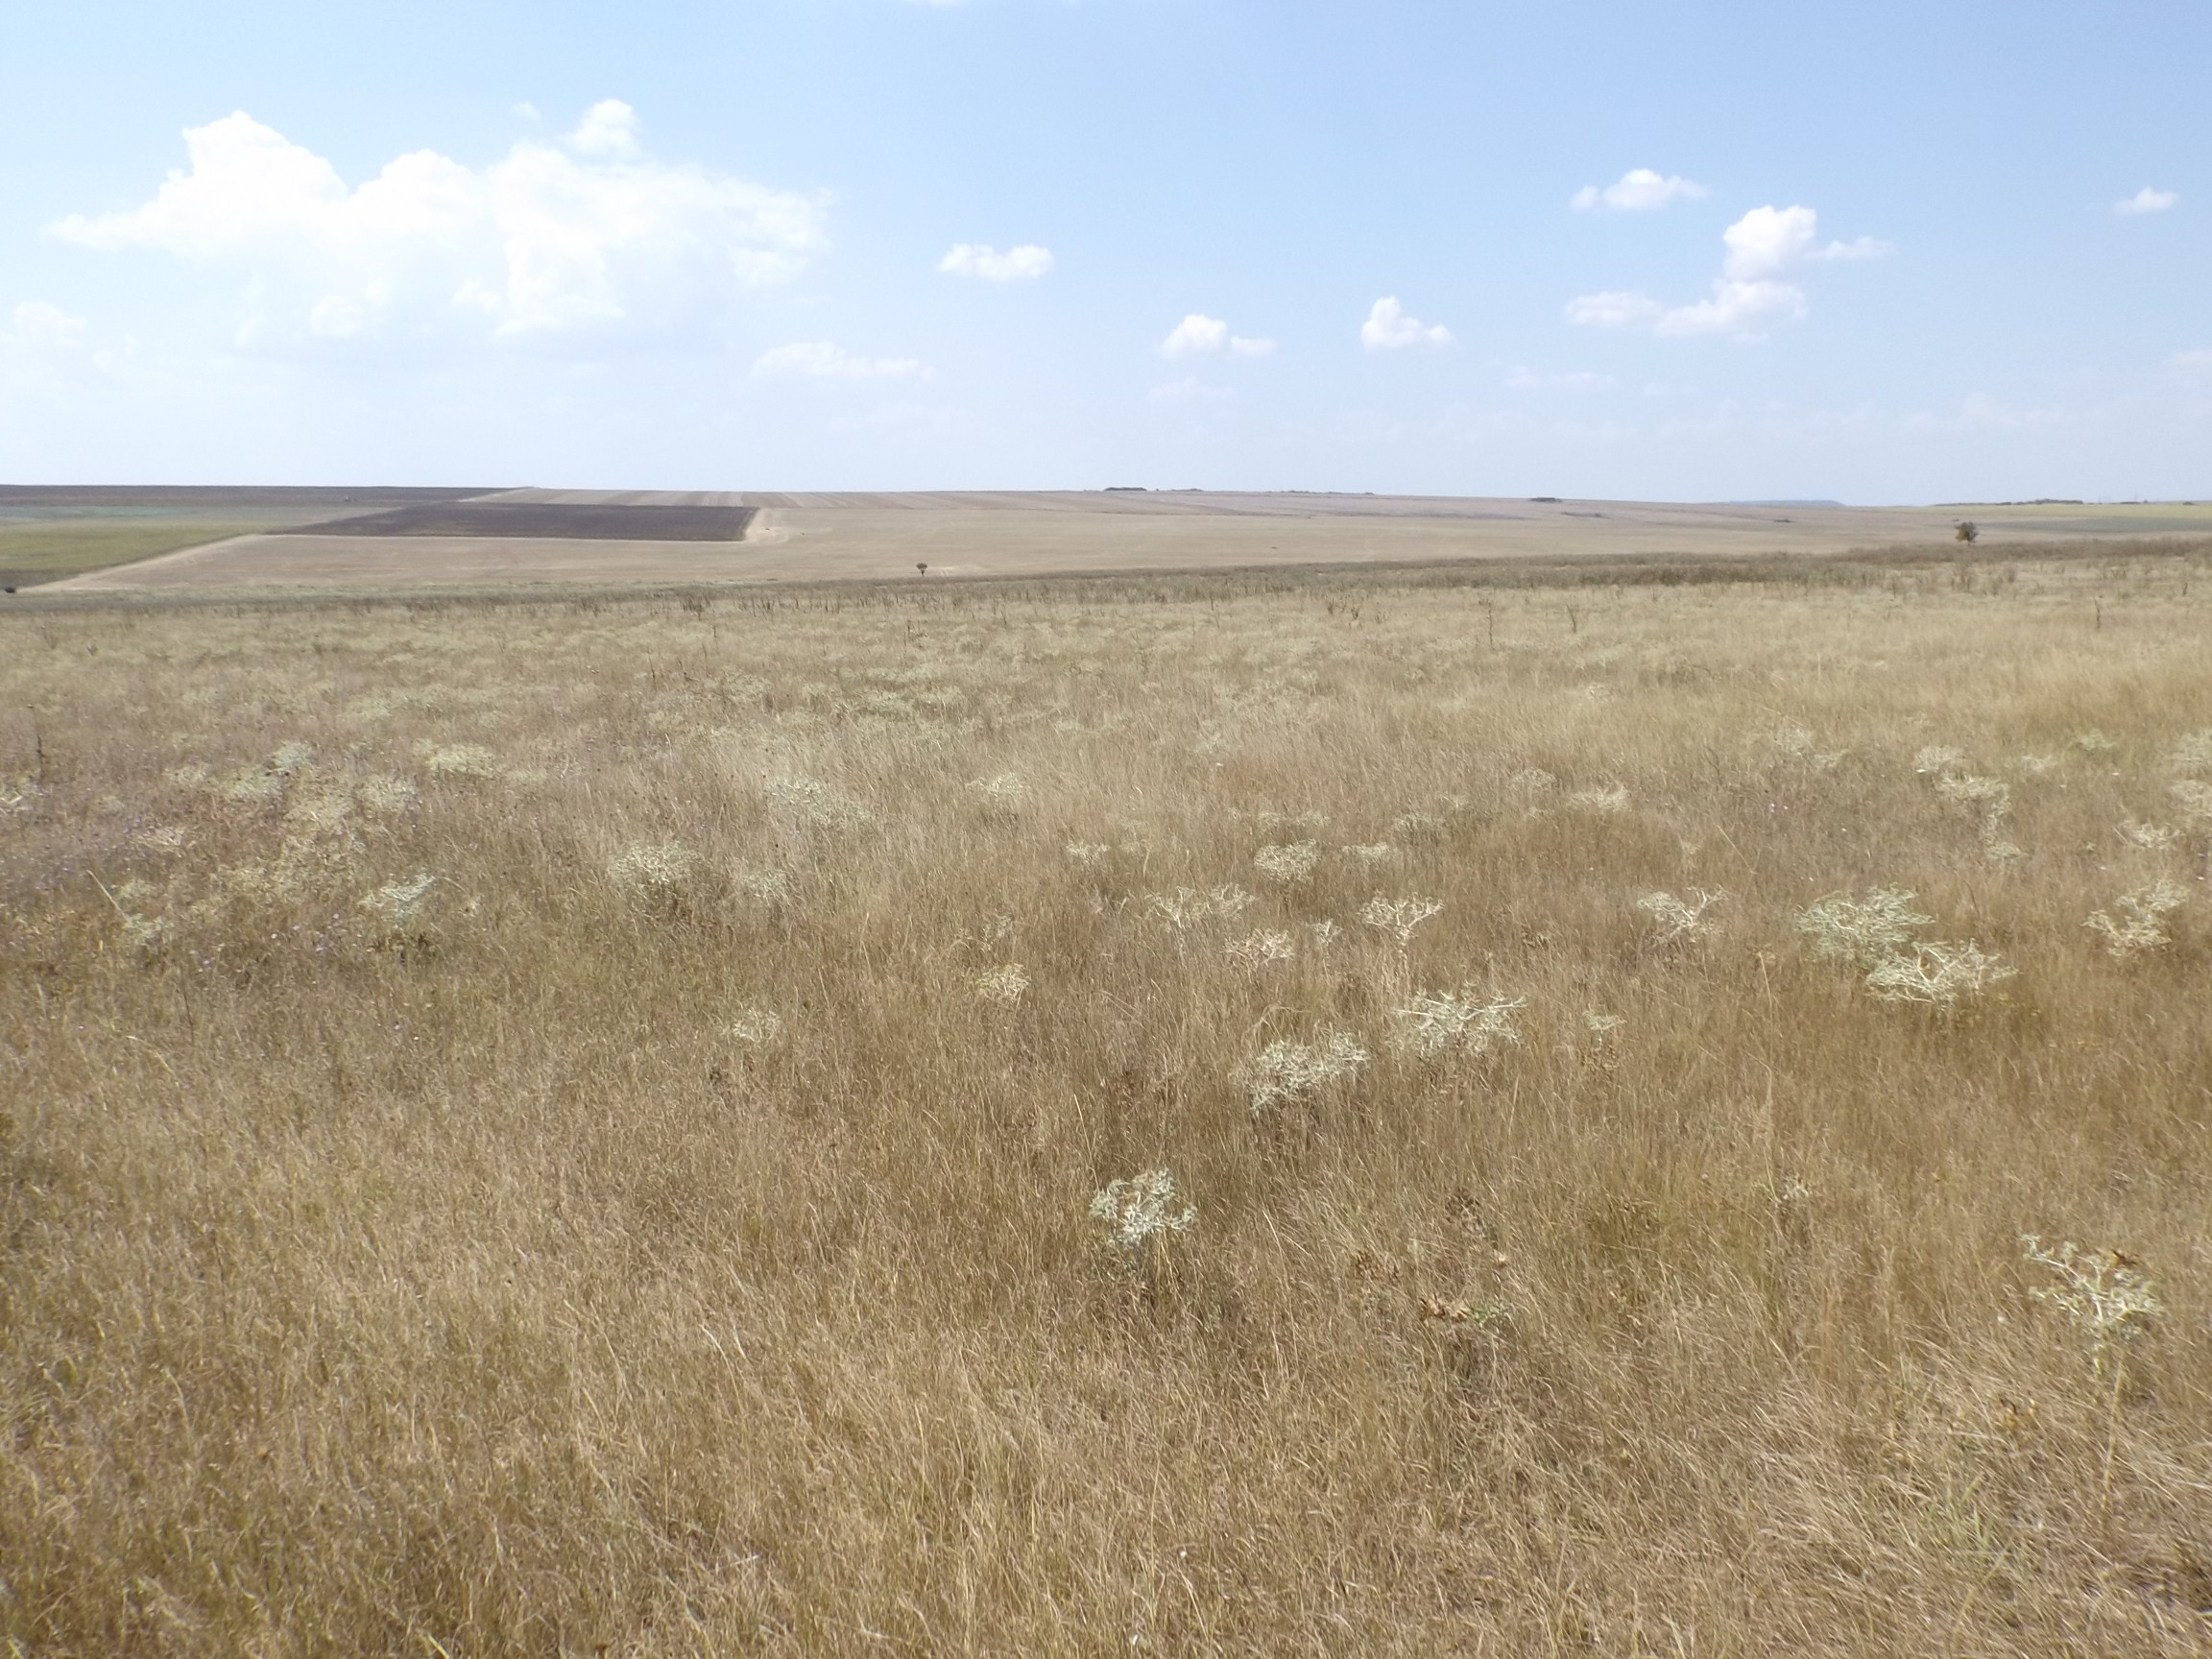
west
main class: Grassland
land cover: Grassland without tree/shrub cover
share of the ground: > 75 %
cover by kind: herbaceous plants 100 %
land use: Semi-natural and natural areas not in use
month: August
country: BG
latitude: 43.3098
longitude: 27.5000
